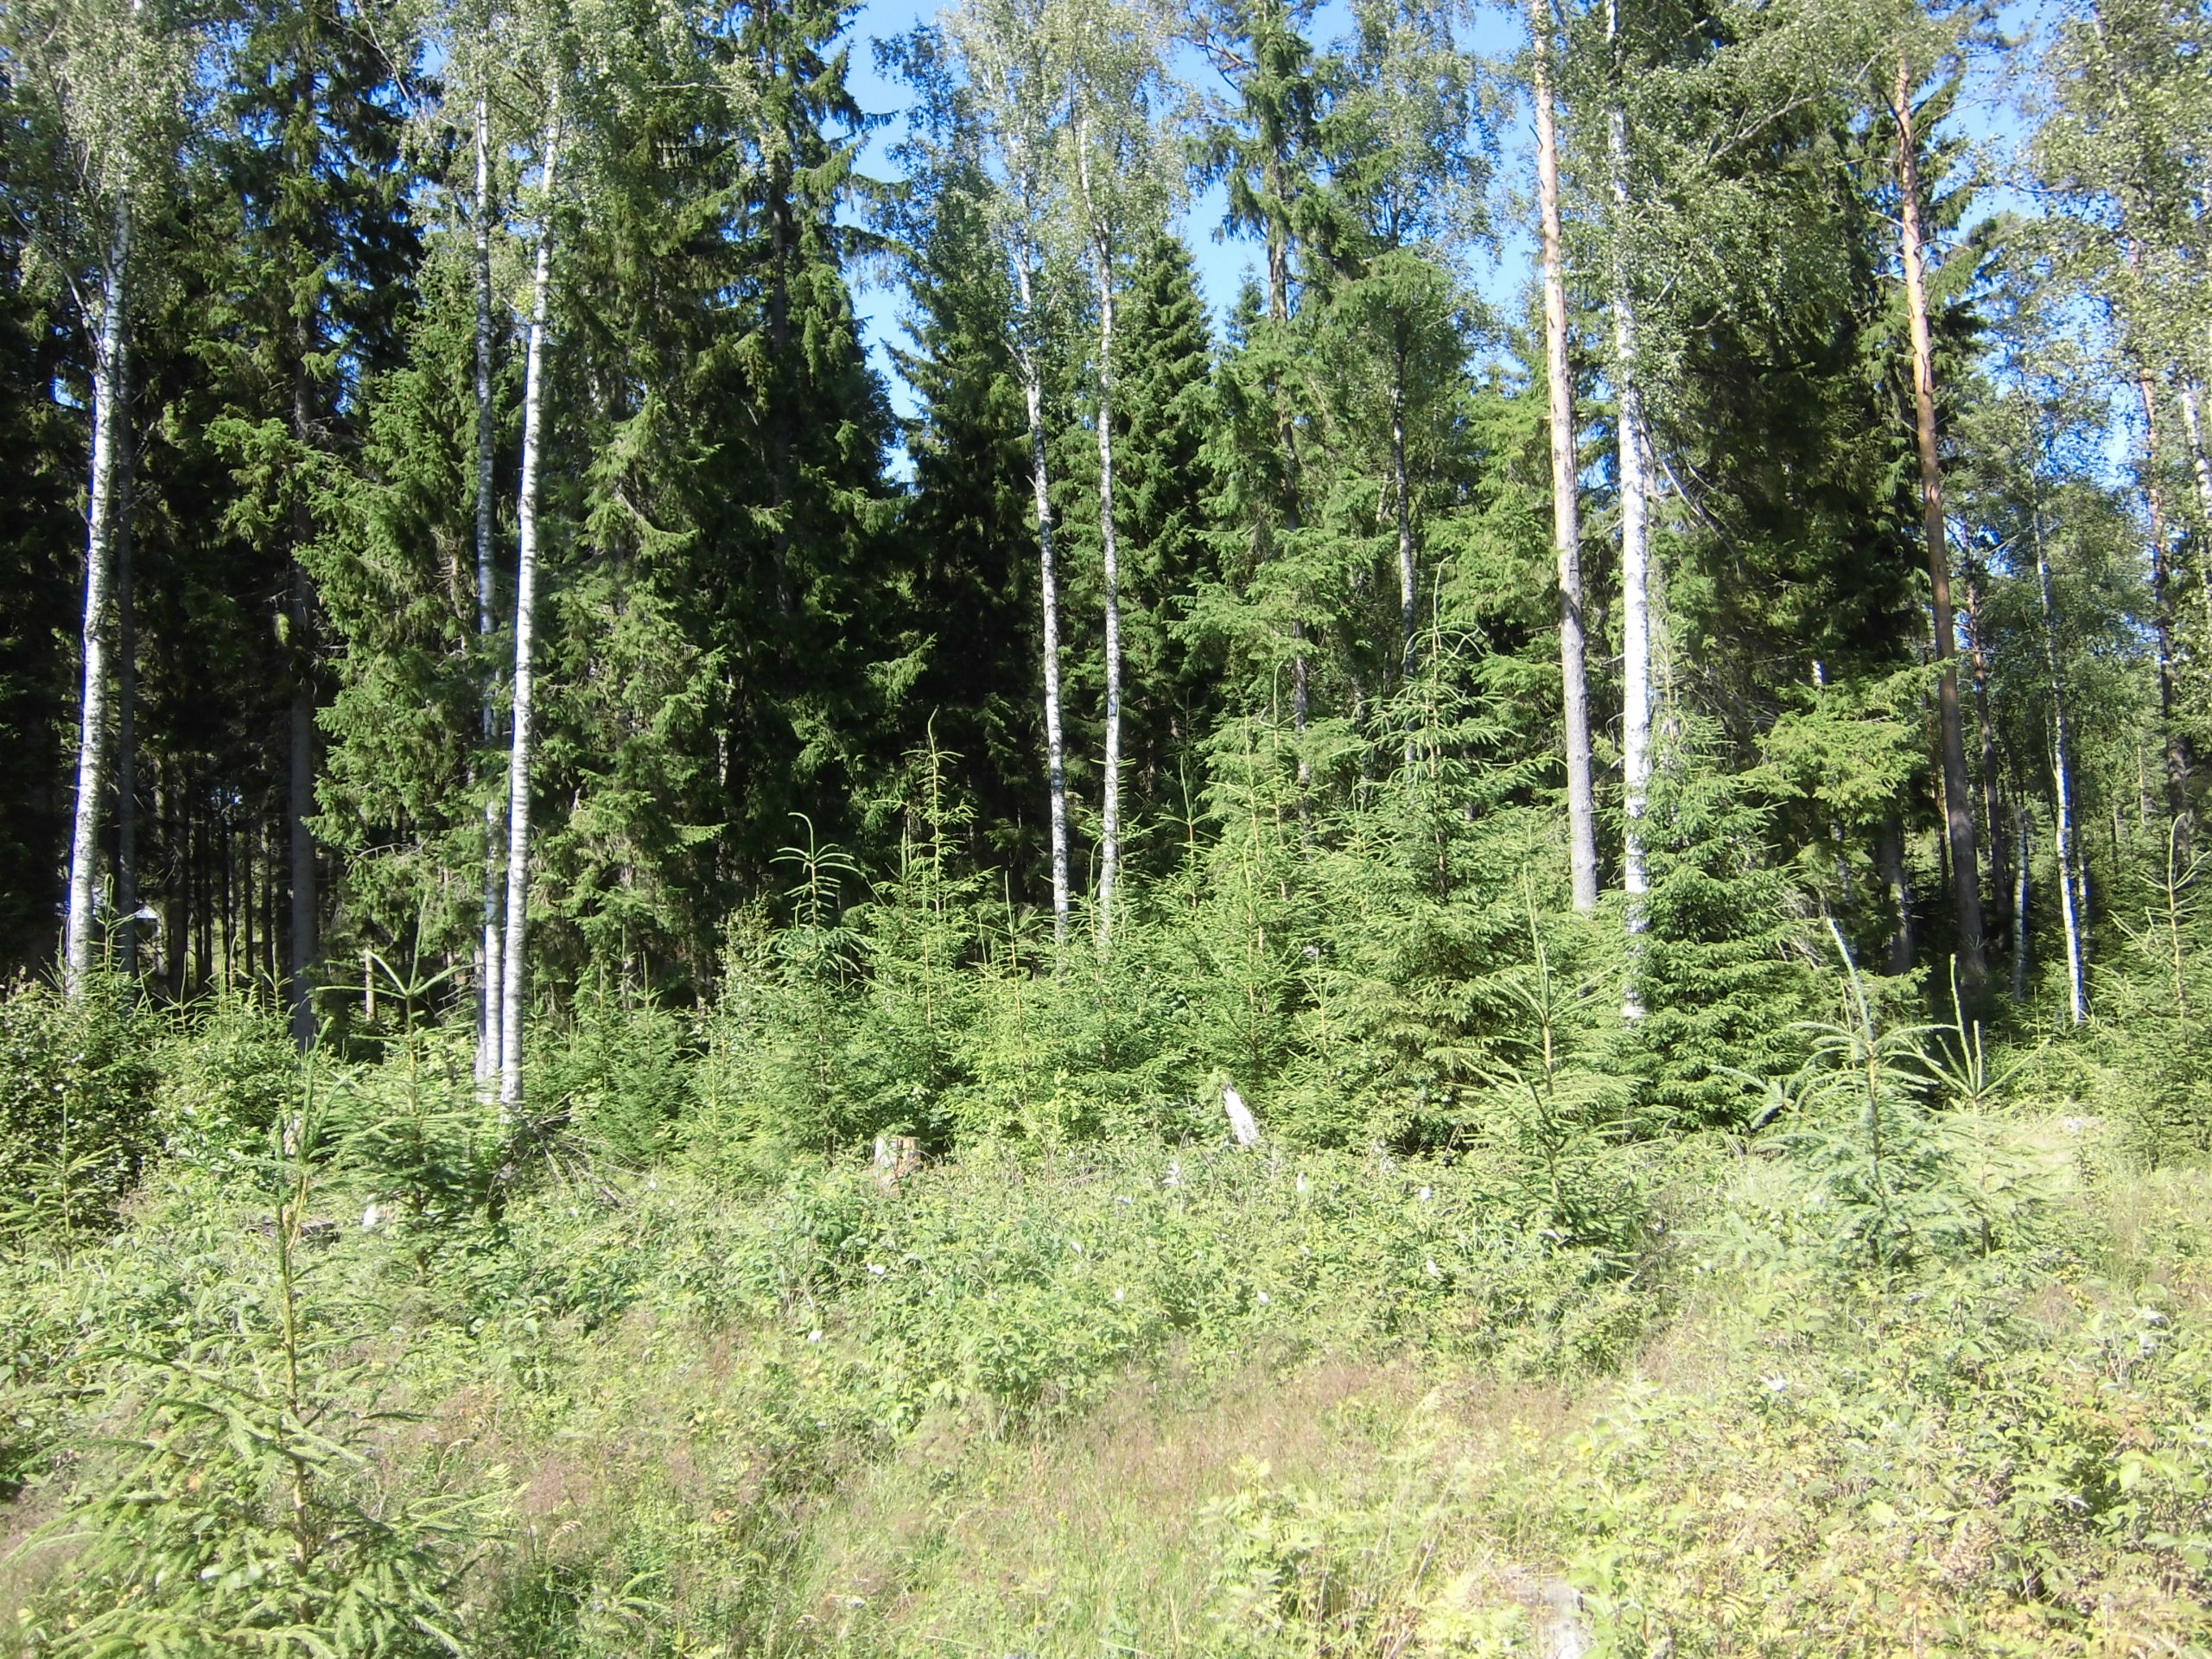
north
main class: Woodland
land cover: Spruce dominated mixed woodland
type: boreal forest
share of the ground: 25 - 50 %
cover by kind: herbaceous plants 35 %, shrubs 30 %, coniferous forest trees 15 %, broadleaved forest trees 15 %, lichens and mosses 5 %
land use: Forestry
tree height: < 5 m
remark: Clear cut
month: July
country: SE
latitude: 57.2822
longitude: 15.3884
